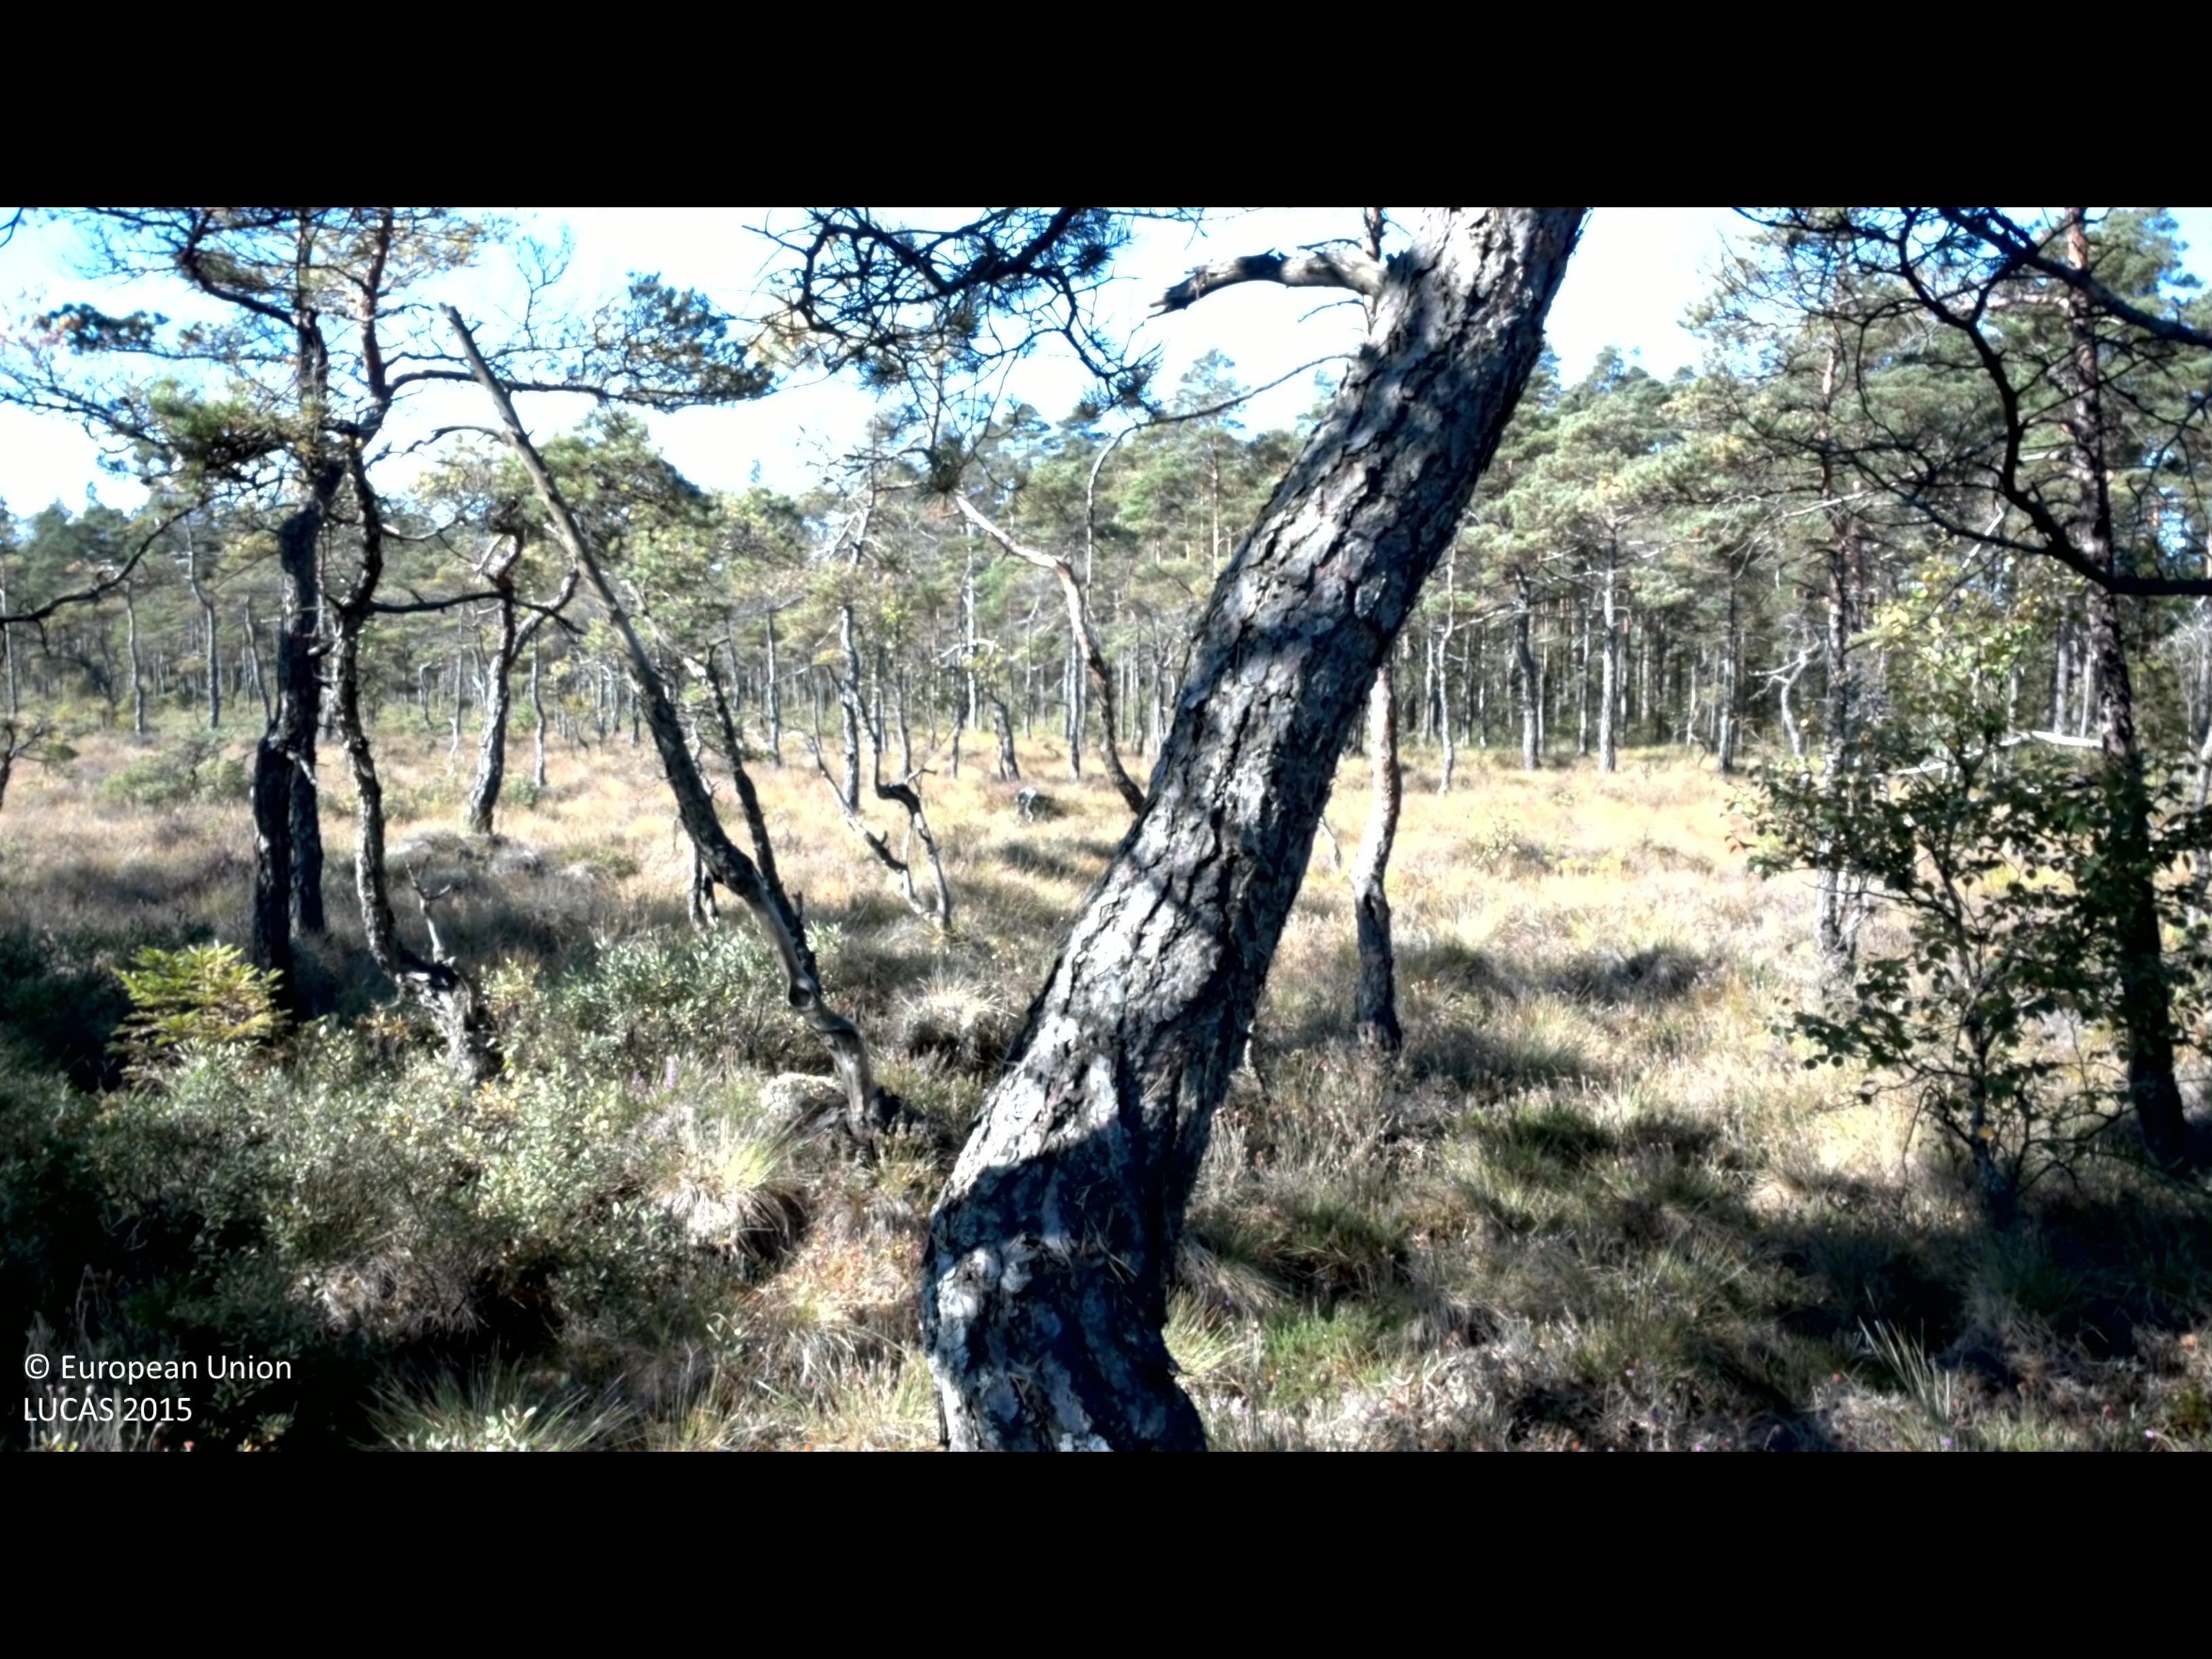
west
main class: Woodland
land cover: Pine dominated coniferous woodland
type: mire and swamp forests
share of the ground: 50 - 75 %
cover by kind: coniferous forest trees 65 %, shrubs 20 %, herbaceous plants 10 %, broadleaved forest trees 5 %
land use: Semi-natural and natural areas not in use
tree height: > 5 m
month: September
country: SE
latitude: 57.0661
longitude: 13.1792
